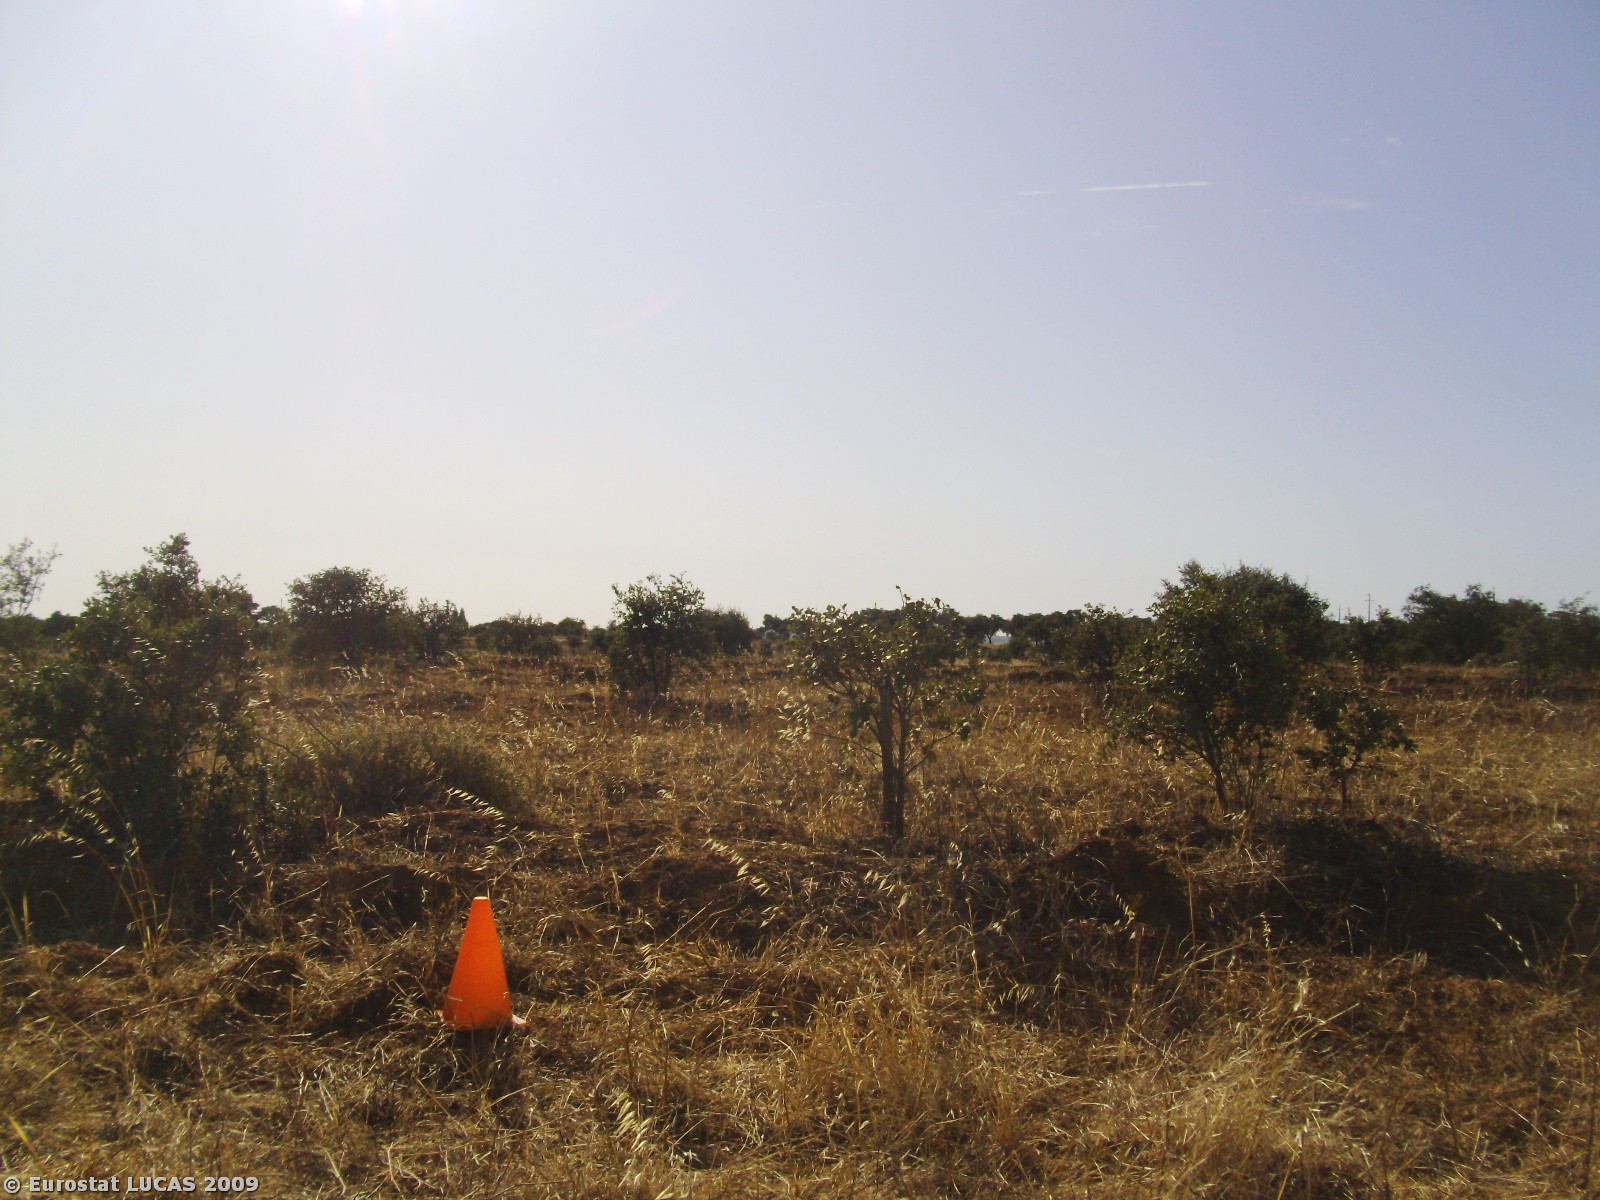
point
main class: Woodland
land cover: Broadleaved woodland
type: broadleaved evergreen forest
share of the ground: 50 - 75 %
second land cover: Spontaneously vegetated surfaces
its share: 10 - 25 %
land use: Forestry
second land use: Fallow land
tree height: > 5 m
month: August
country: PT
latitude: 38.1753
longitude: -7.7328
